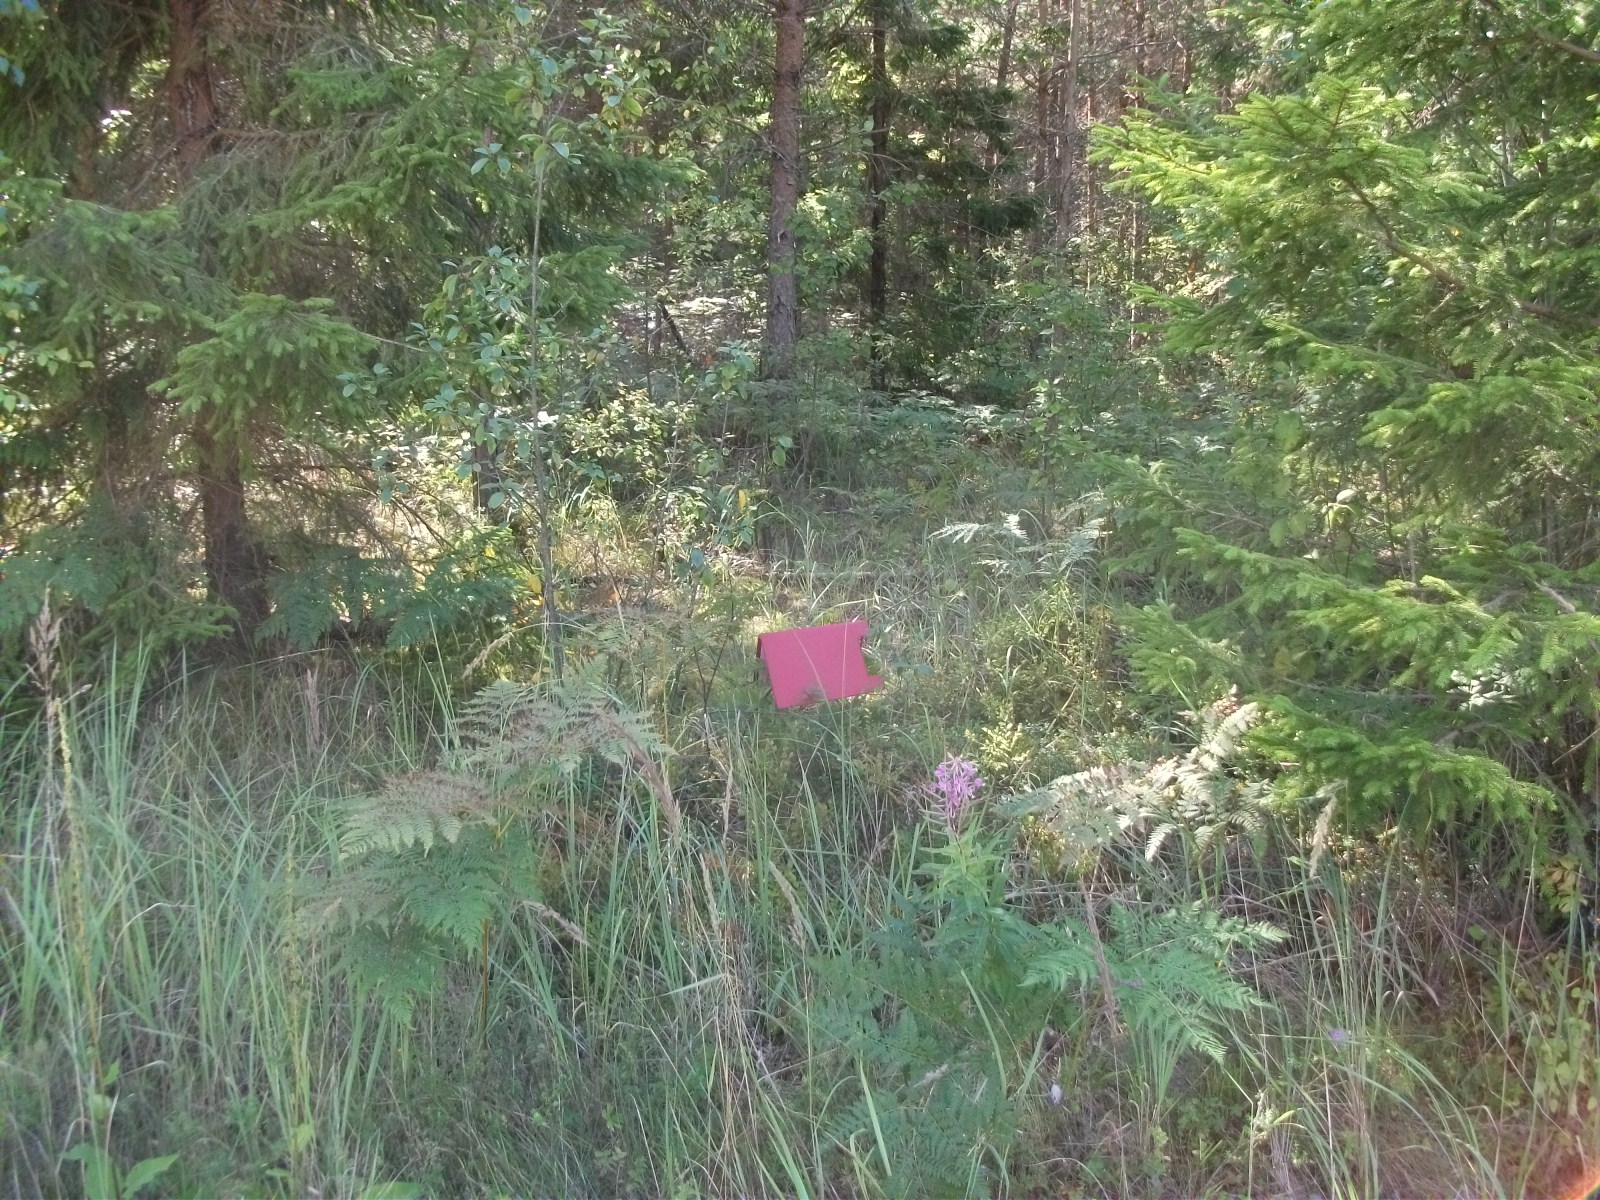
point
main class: Woodland
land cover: Other coniferous woodland
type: hemiboreal forest and nemoral coniferous forest and mixed broadleaved-coniferous forest
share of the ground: > 75 %
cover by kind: coniferous forest trees 80 %, herbaceous plants 10 %, shrubs 5 %, lichens and mosses 5 %
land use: Forestry
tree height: > 5 m
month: August
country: LV
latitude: 56.6109
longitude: 26.1197
